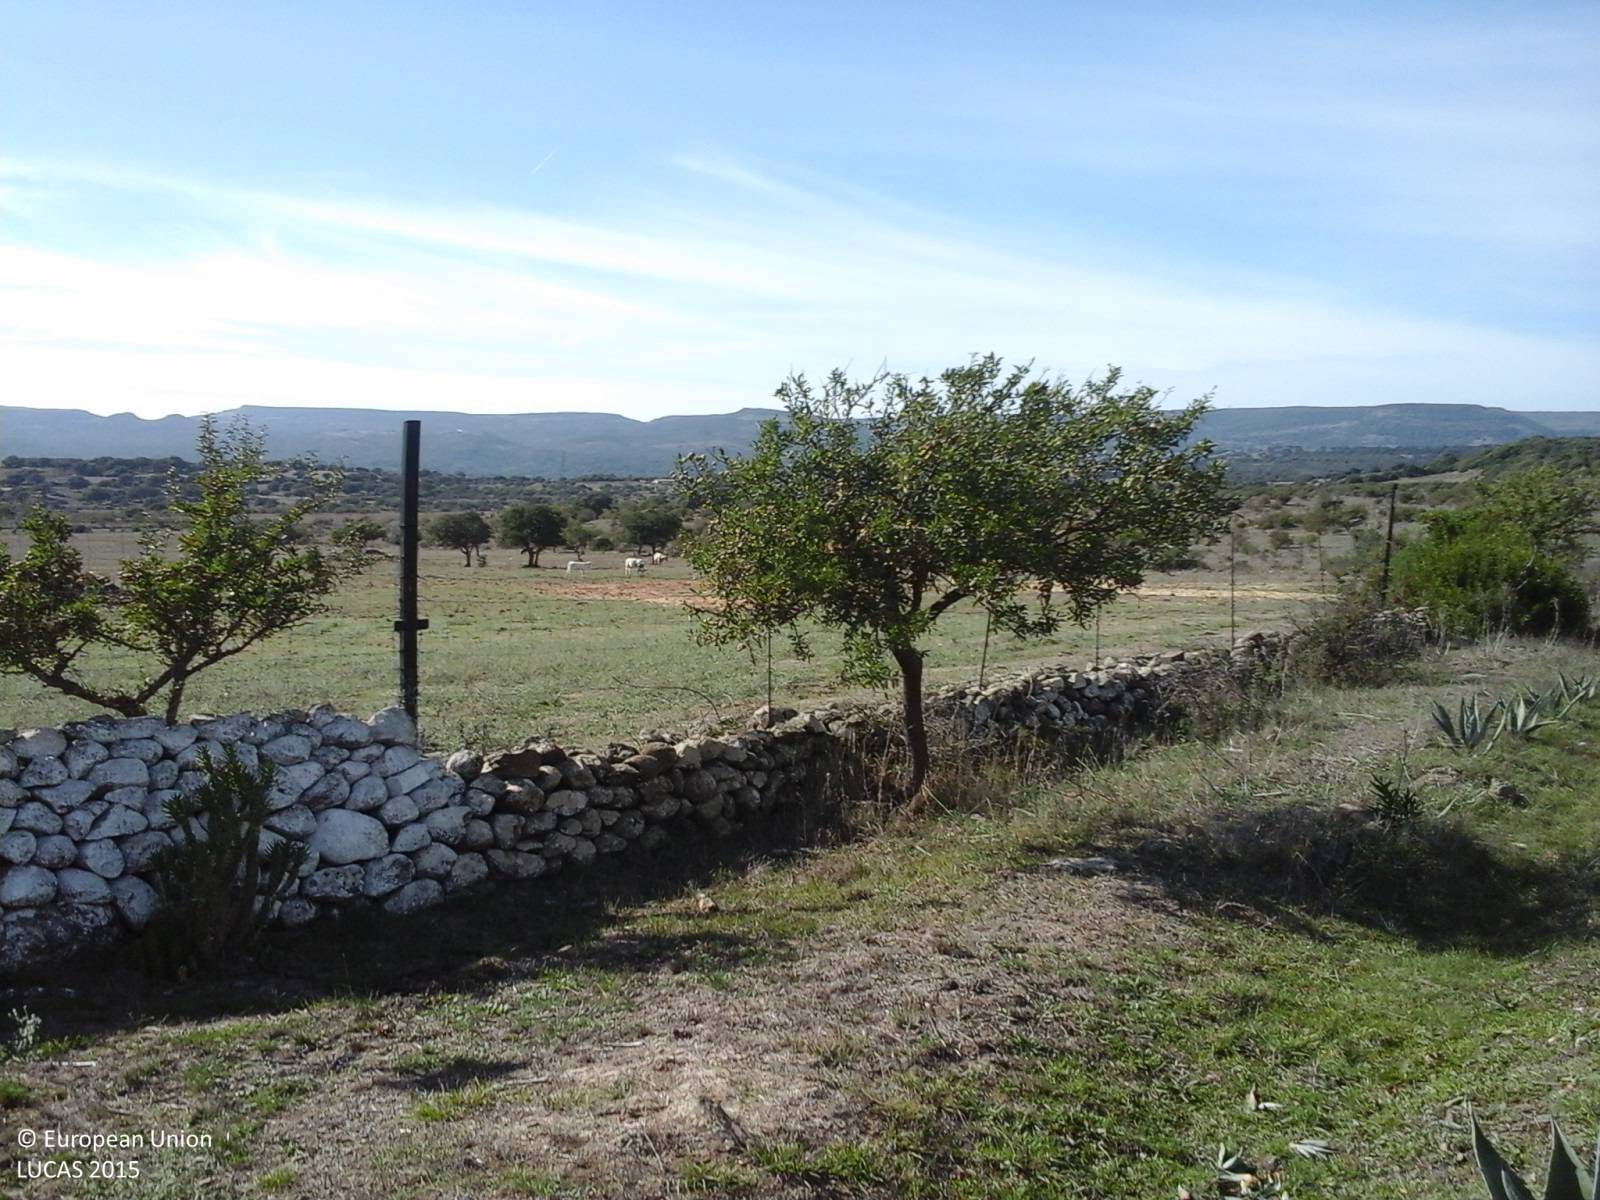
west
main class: Grassland
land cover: Grassland without tree/shrub cover
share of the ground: > 75 %
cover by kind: herbaceous plants 100 %
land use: Agriculture (excluding fallow land and kitchen gardens)
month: October
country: IT
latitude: 40.4193
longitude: 8.5342
